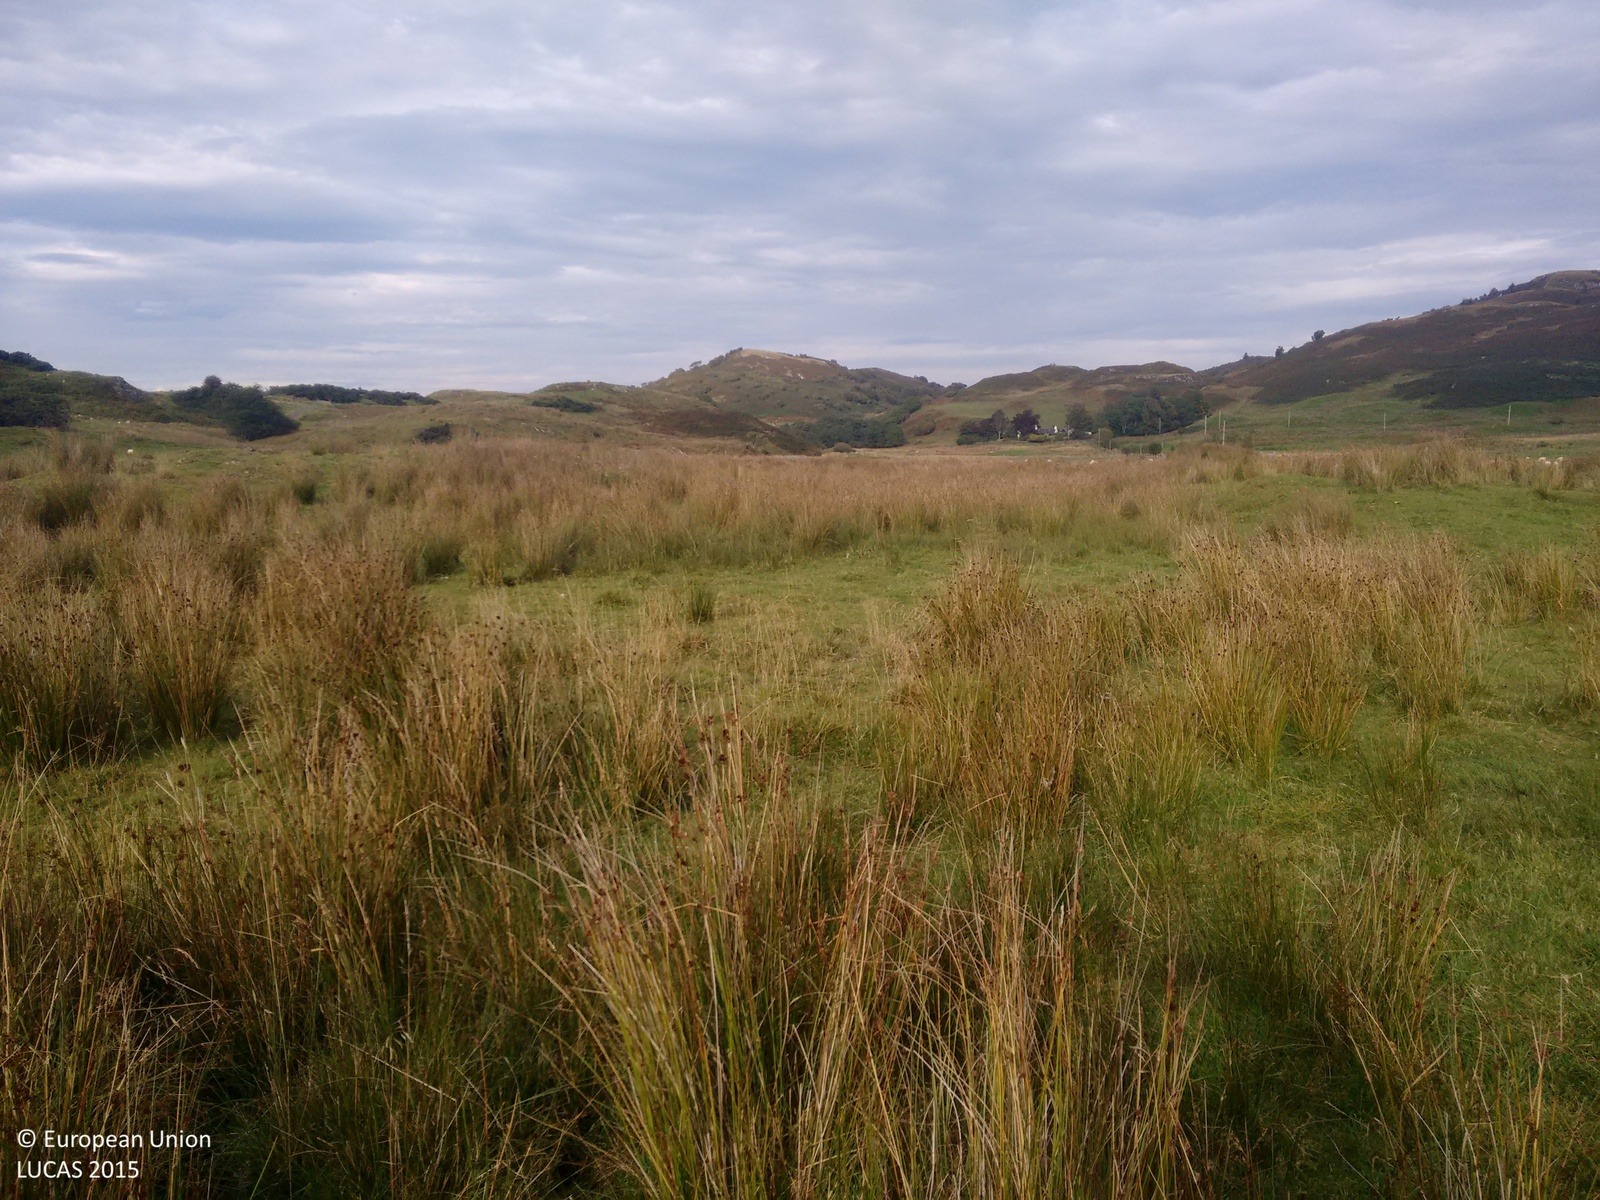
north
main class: Grassland
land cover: Grassland without tree/shrub cover
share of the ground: > 75 %
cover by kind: herbaceous plants 95 %, shrubs 5 %
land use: Agriculture (excluding fallow land and kitchen gardens)
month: September
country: GB
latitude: 56.4059
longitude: -5.3995
